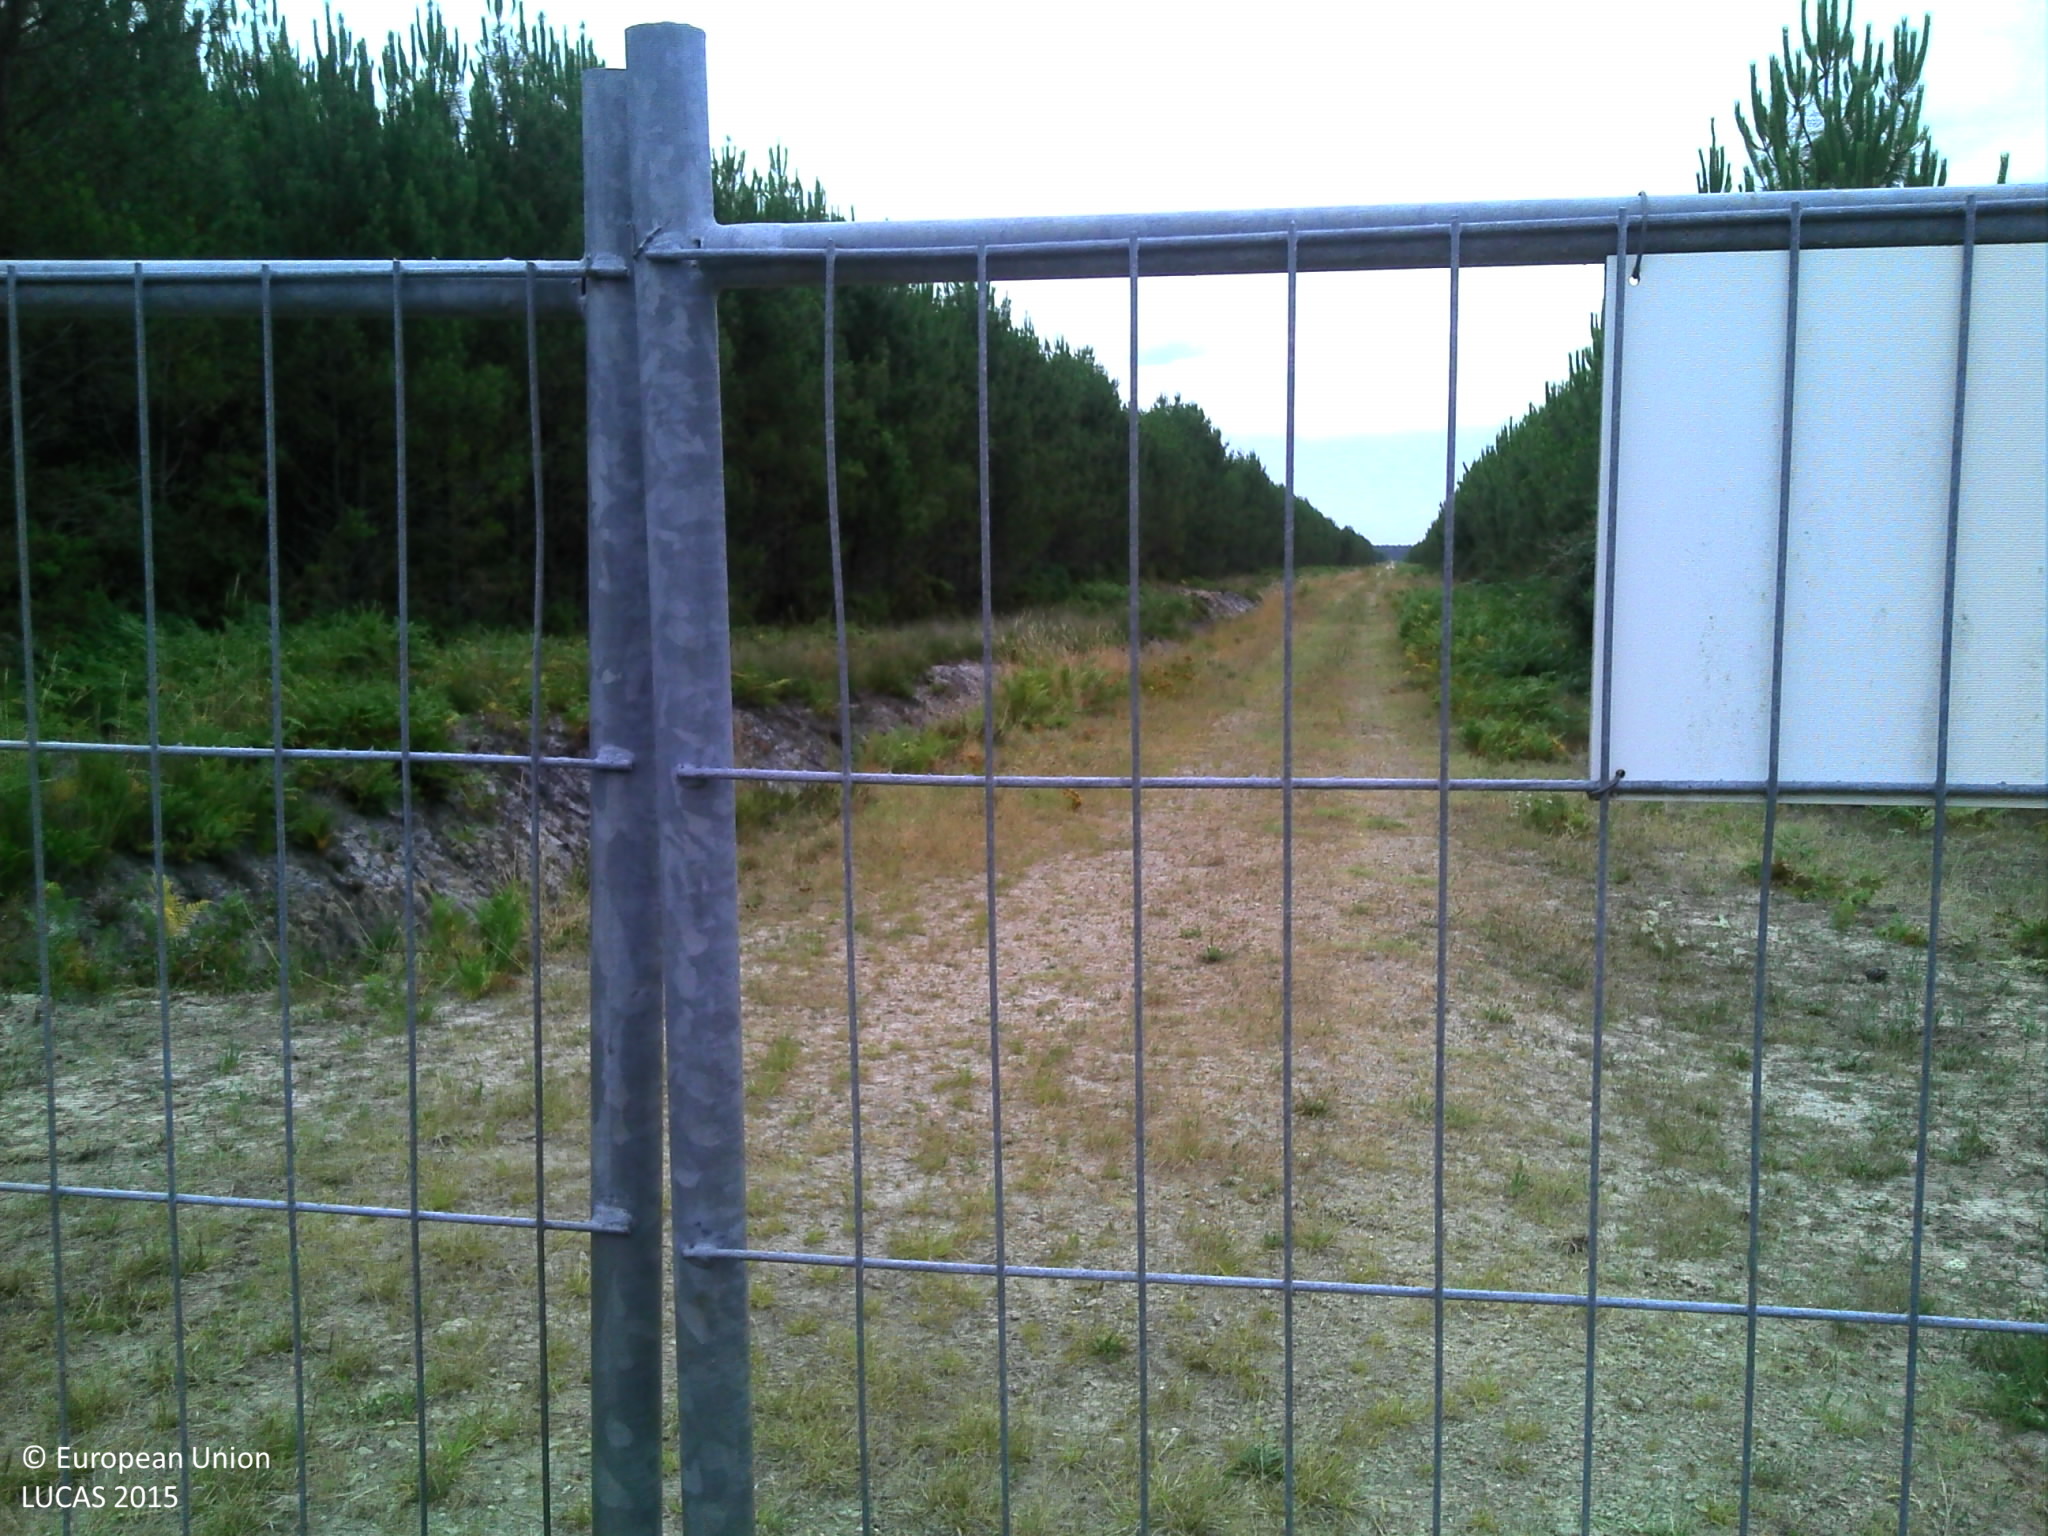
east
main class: Woodland
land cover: Pine dominated coniferous woodland
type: coniferous forest of the mediterranean region
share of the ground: > 75 %
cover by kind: coniferous forest trees 100 %
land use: Forestry
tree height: > 5 m
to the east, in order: Pine dominated coniferous woodland; Spontaneously vegetated surfaces; Ditches and canals; Tracks; Grass margins; Pine dominated coniferous woodland
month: July
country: FR
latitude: 44.2770
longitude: -1.1339
